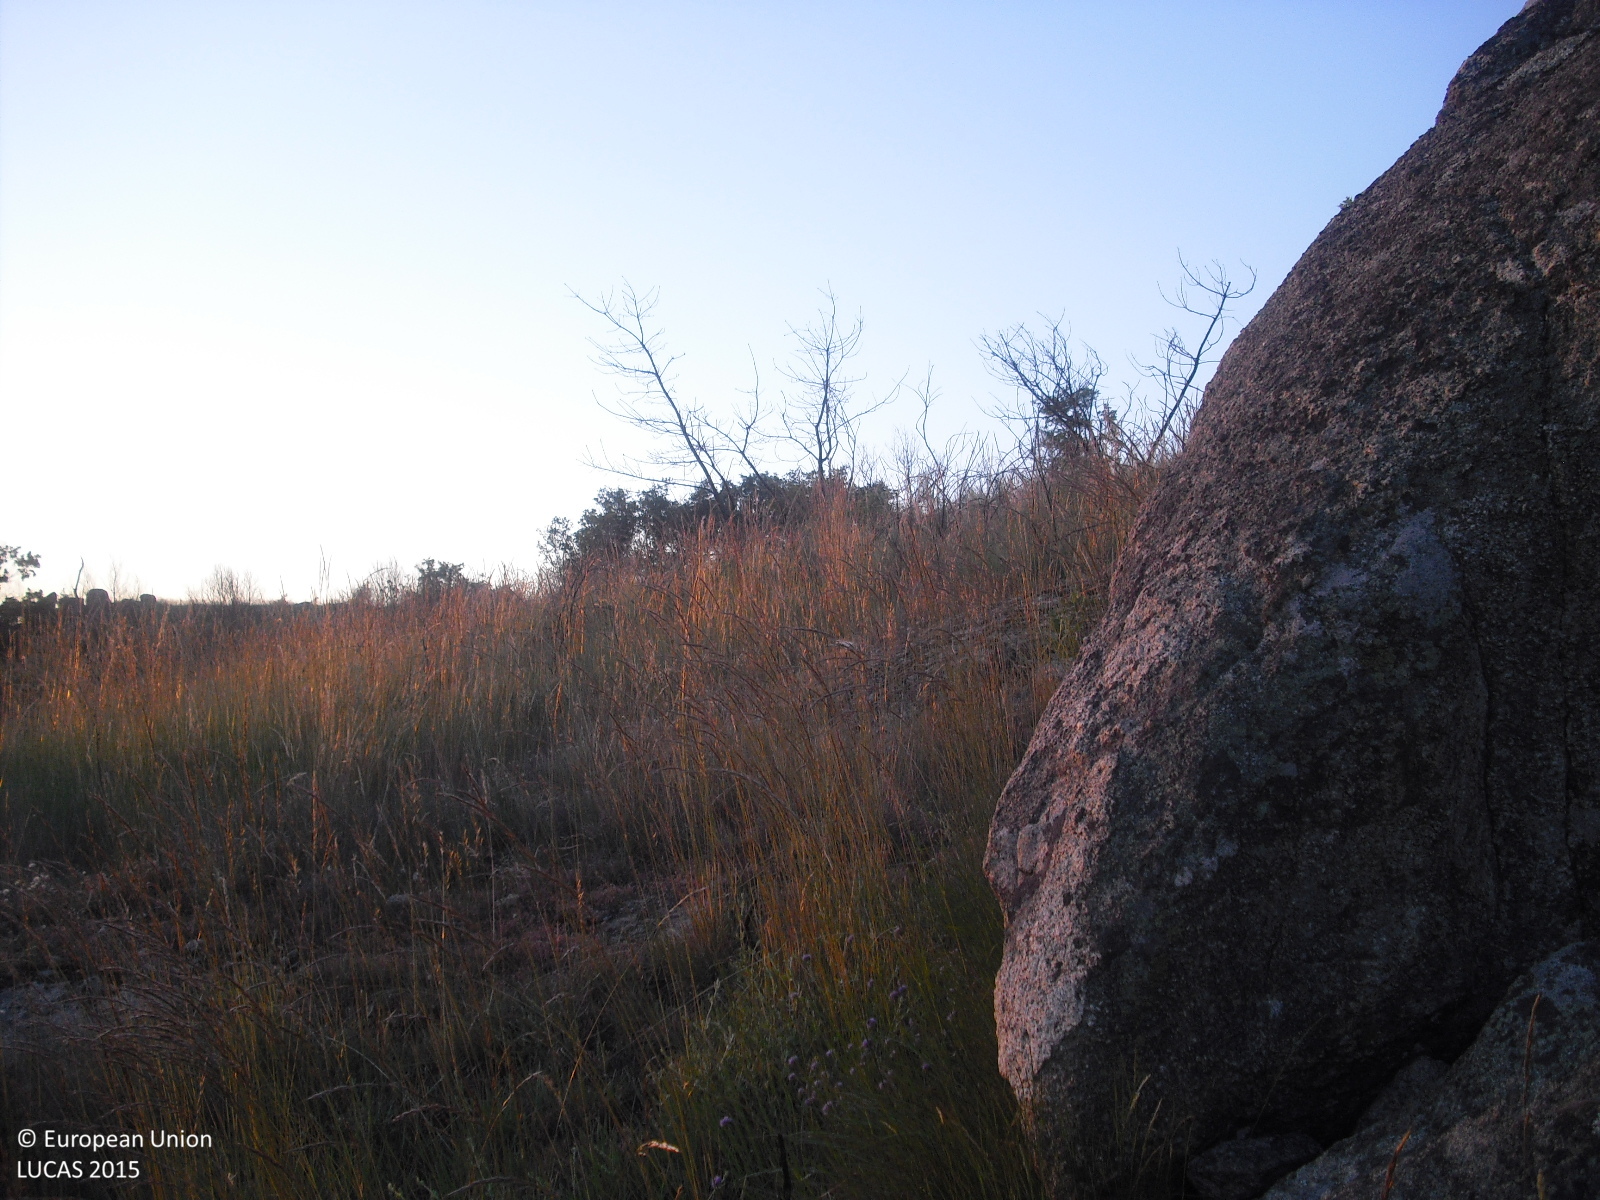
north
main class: Artificial land
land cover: Other artificial areas
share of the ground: < 10 %
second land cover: Shrubland with sparse tree cover
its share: 25 - 50 %
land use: Electricity, gas and thermal power distribution
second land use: Agriculture (excluding fallow land and kitchen gardens)
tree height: < 5 m
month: May
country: ES
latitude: 42.2025
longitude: -7.7172
